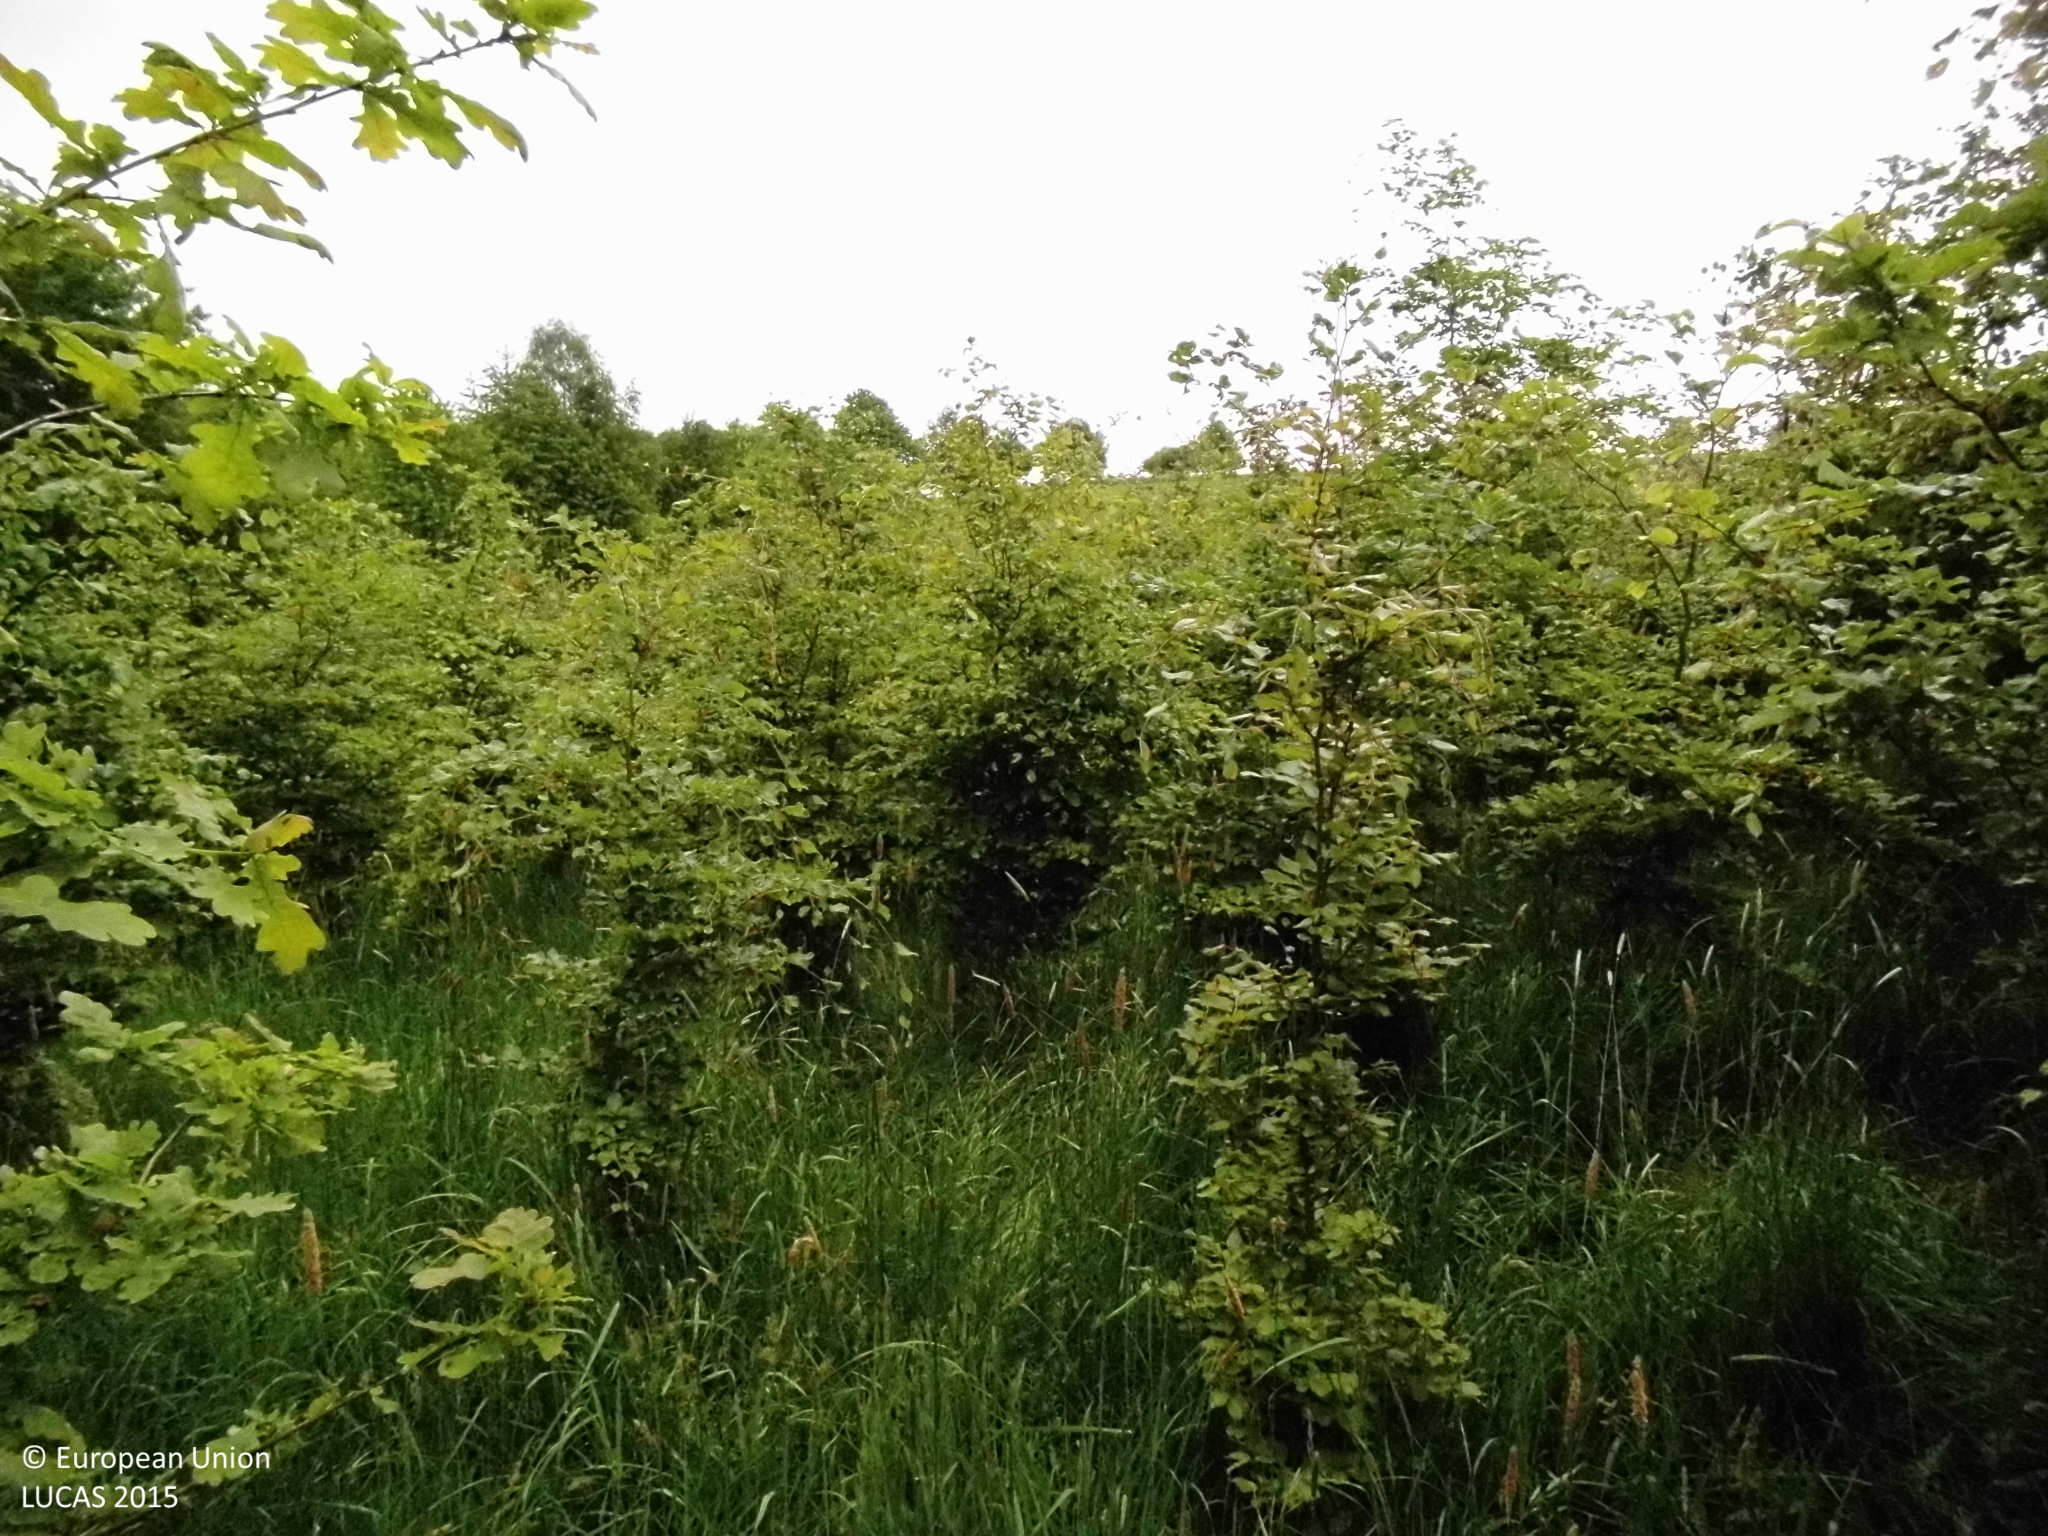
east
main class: Woodland
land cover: Broadleaved woodland
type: mesophytic deciduous forest
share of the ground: 50 - 75 %
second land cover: Grassland without tree/shrub cover
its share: > 75 %
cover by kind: broadleaved forest trees 65 %, herbaceous plants 35 %
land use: Forestry
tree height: < 5 m
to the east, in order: Broadleaved woodland; Grassland without tree/shrub cover; Fences; Grassland without tree/shrub cover; Fences; Broadleaved woodland; Fences; Grassland without tree/shrub cover
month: May
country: DE
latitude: 50.8947
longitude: 7.5122
